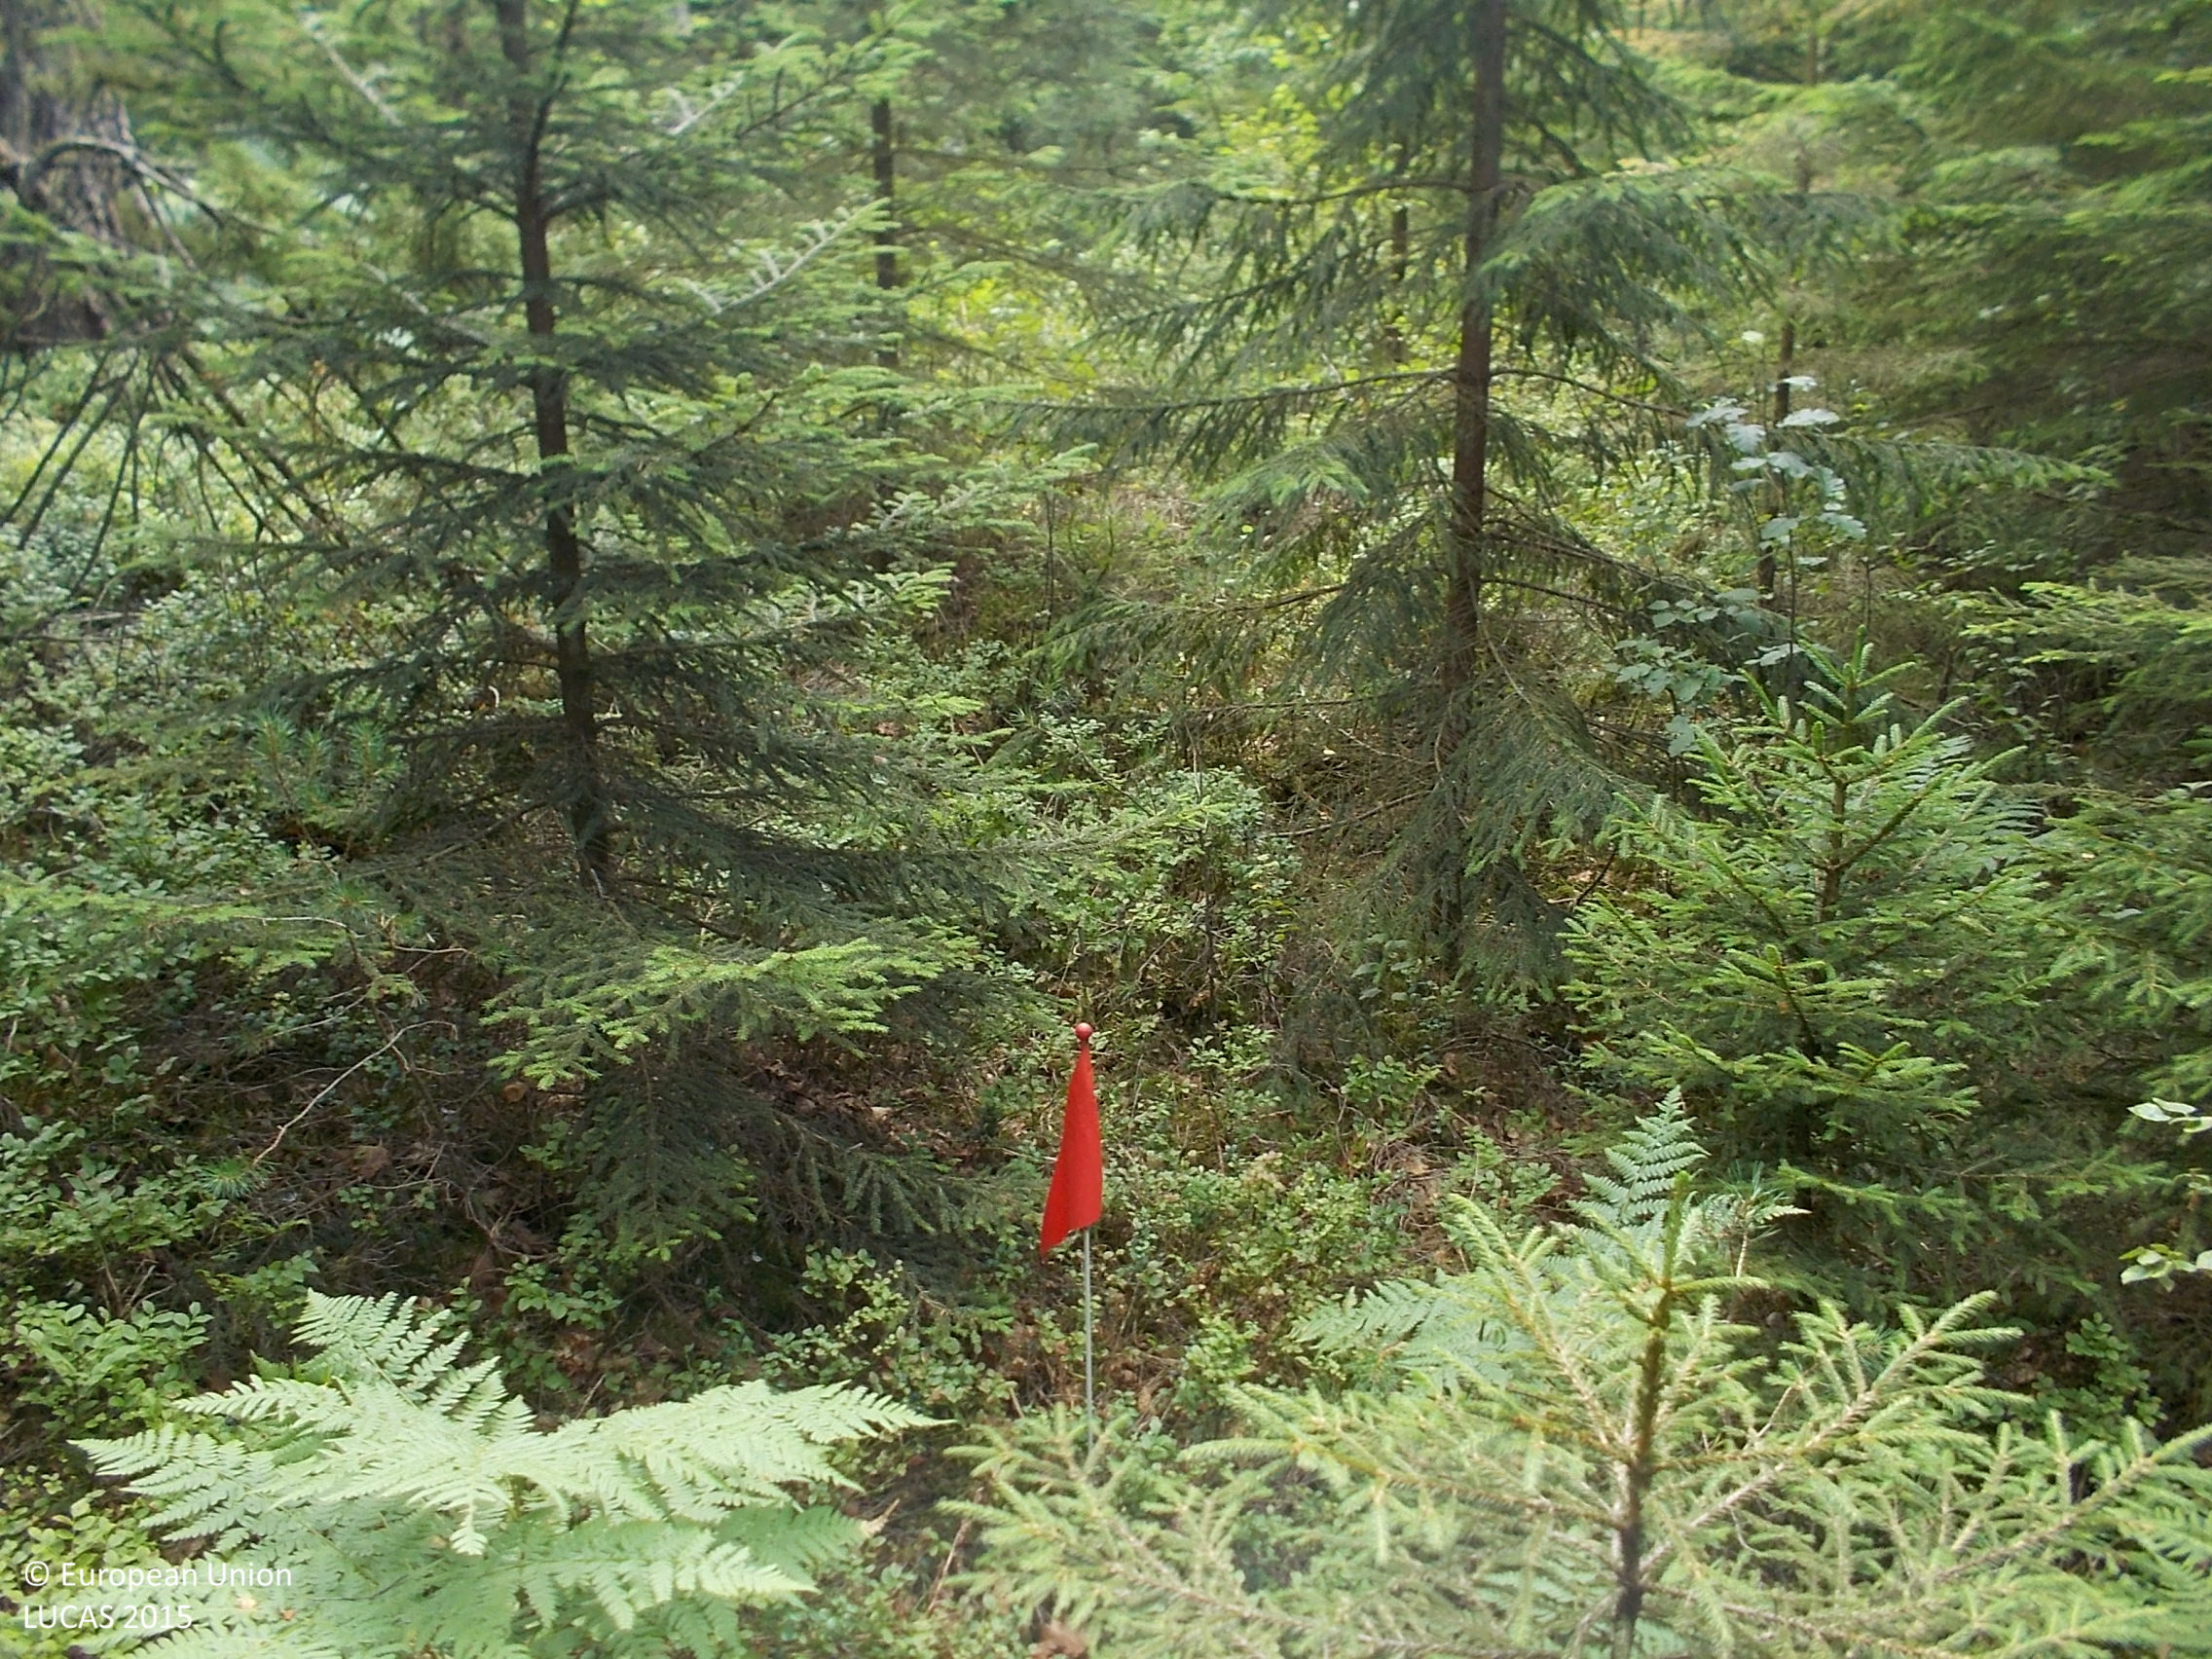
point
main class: Woodland
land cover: Spruce dominated mixed woodland
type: boreal forest
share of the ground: > 75 %
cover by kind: coniferous forest trees 60 %, broadleaved forest trees 25 %, shrubs 10 %, lichens and mosses 5 %
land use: Forestry
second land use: Sport
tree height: > 5 m
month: August
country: SE
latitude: 57.5529
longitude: 12.2525
